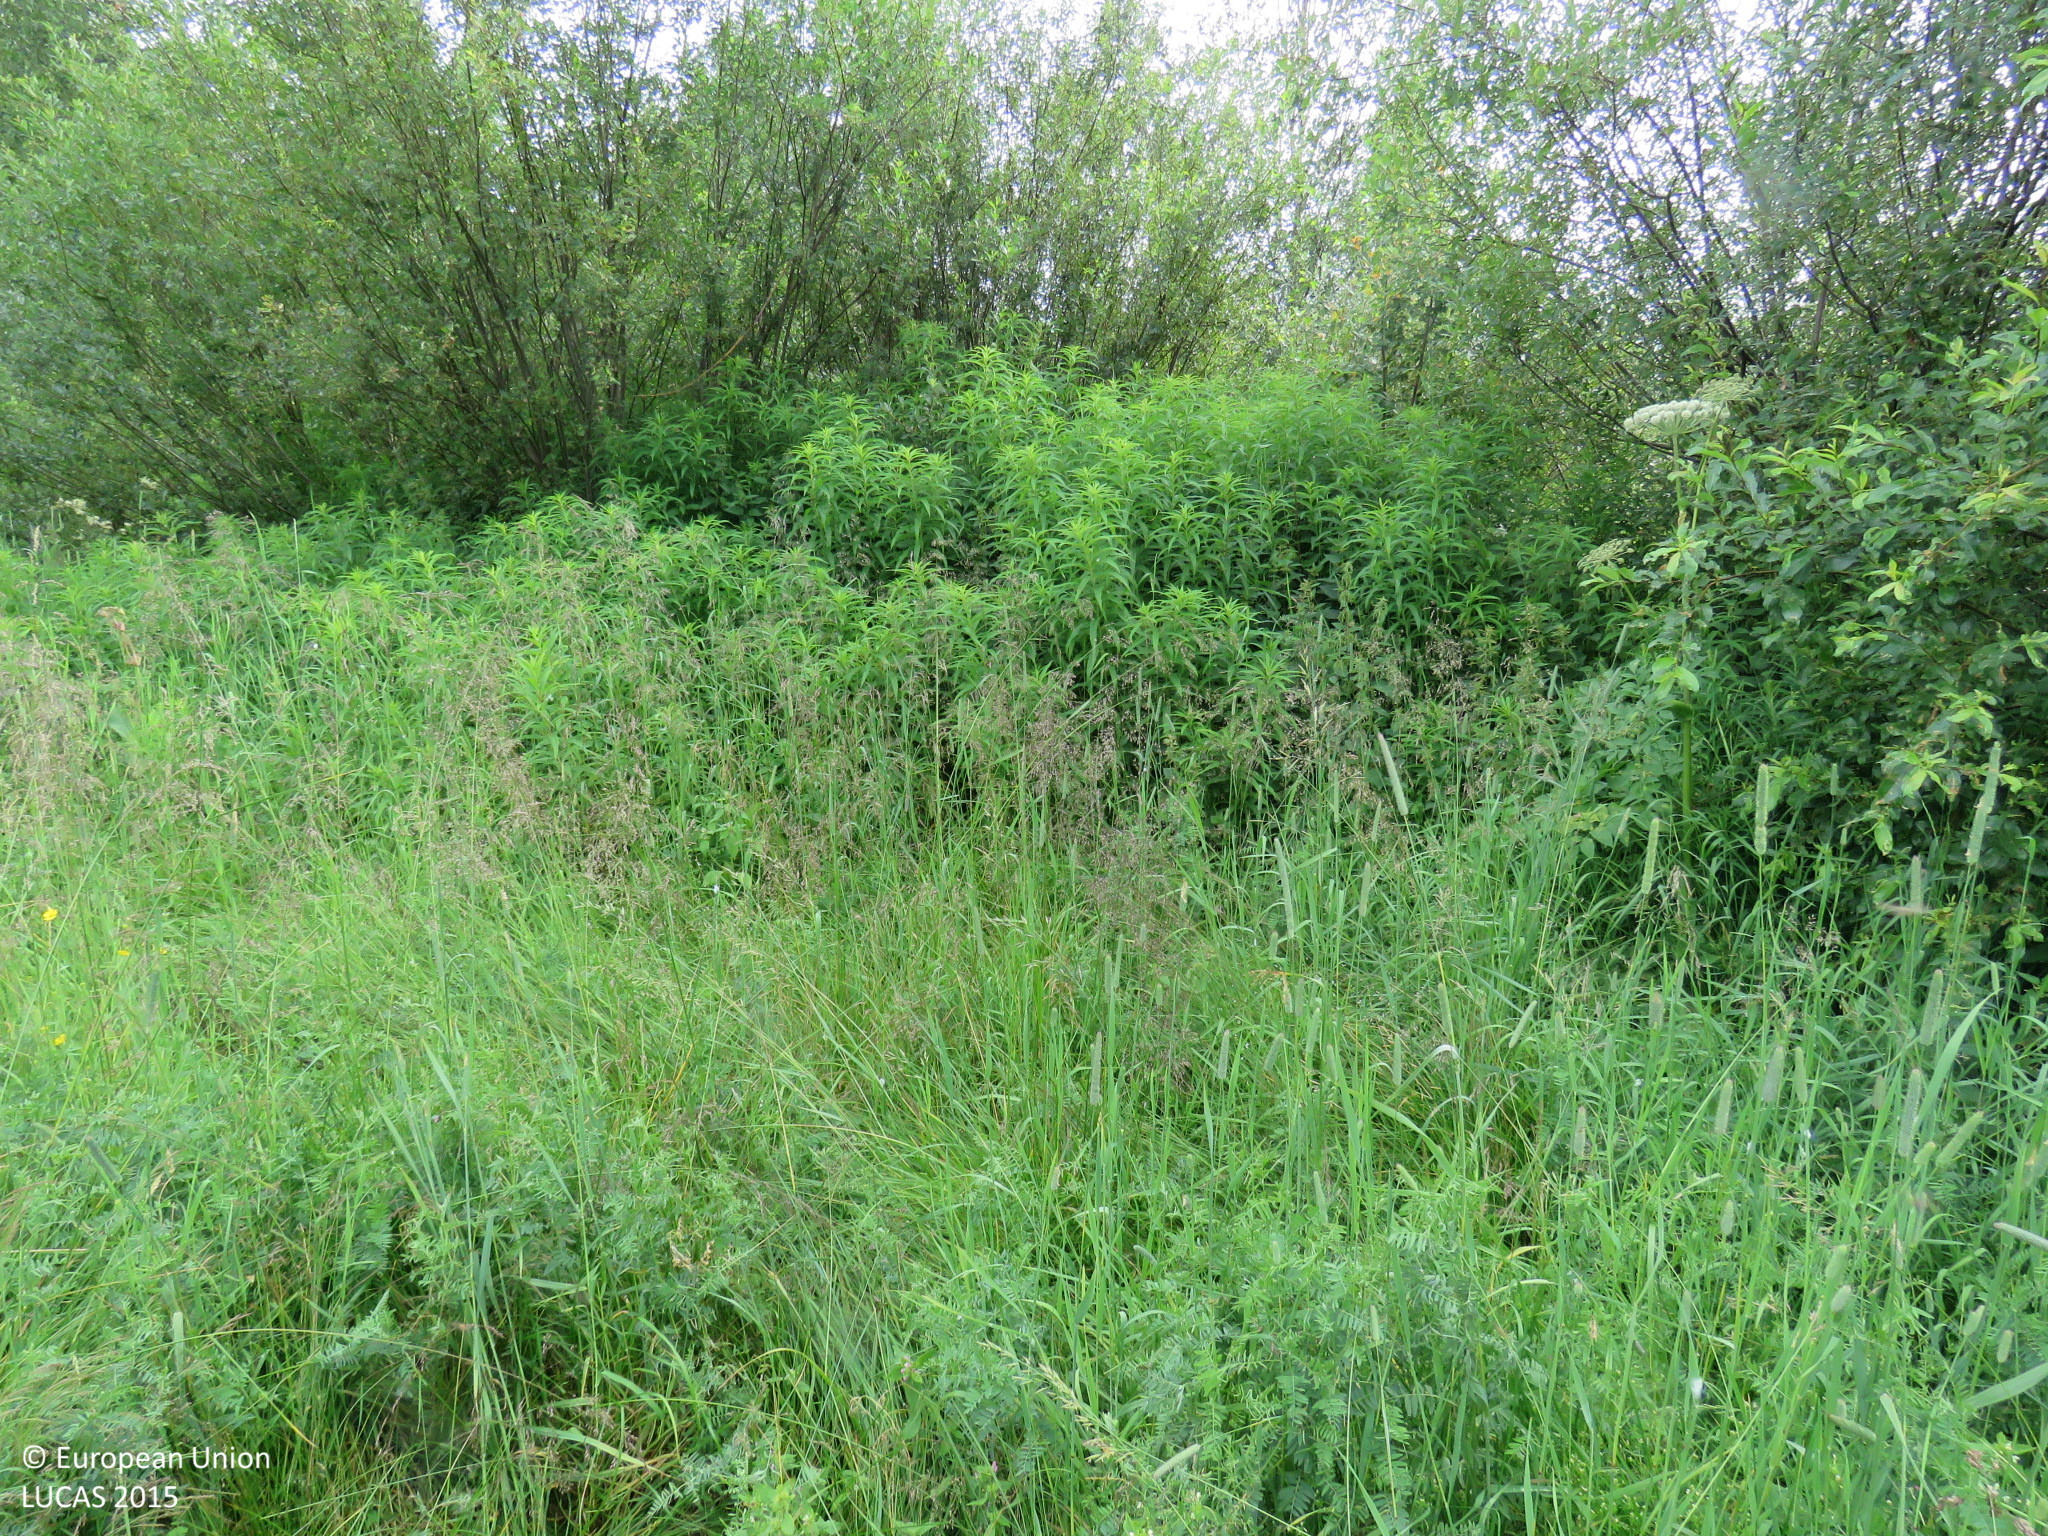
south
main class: Grassland
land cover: Spontaneously vegetated surfaces
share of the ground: > 75 %
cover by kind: herbaceous plants 95 %, shrubs 5 %
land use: Fallow land
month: July
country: FI
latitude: 64.6112
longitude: 26.2225
